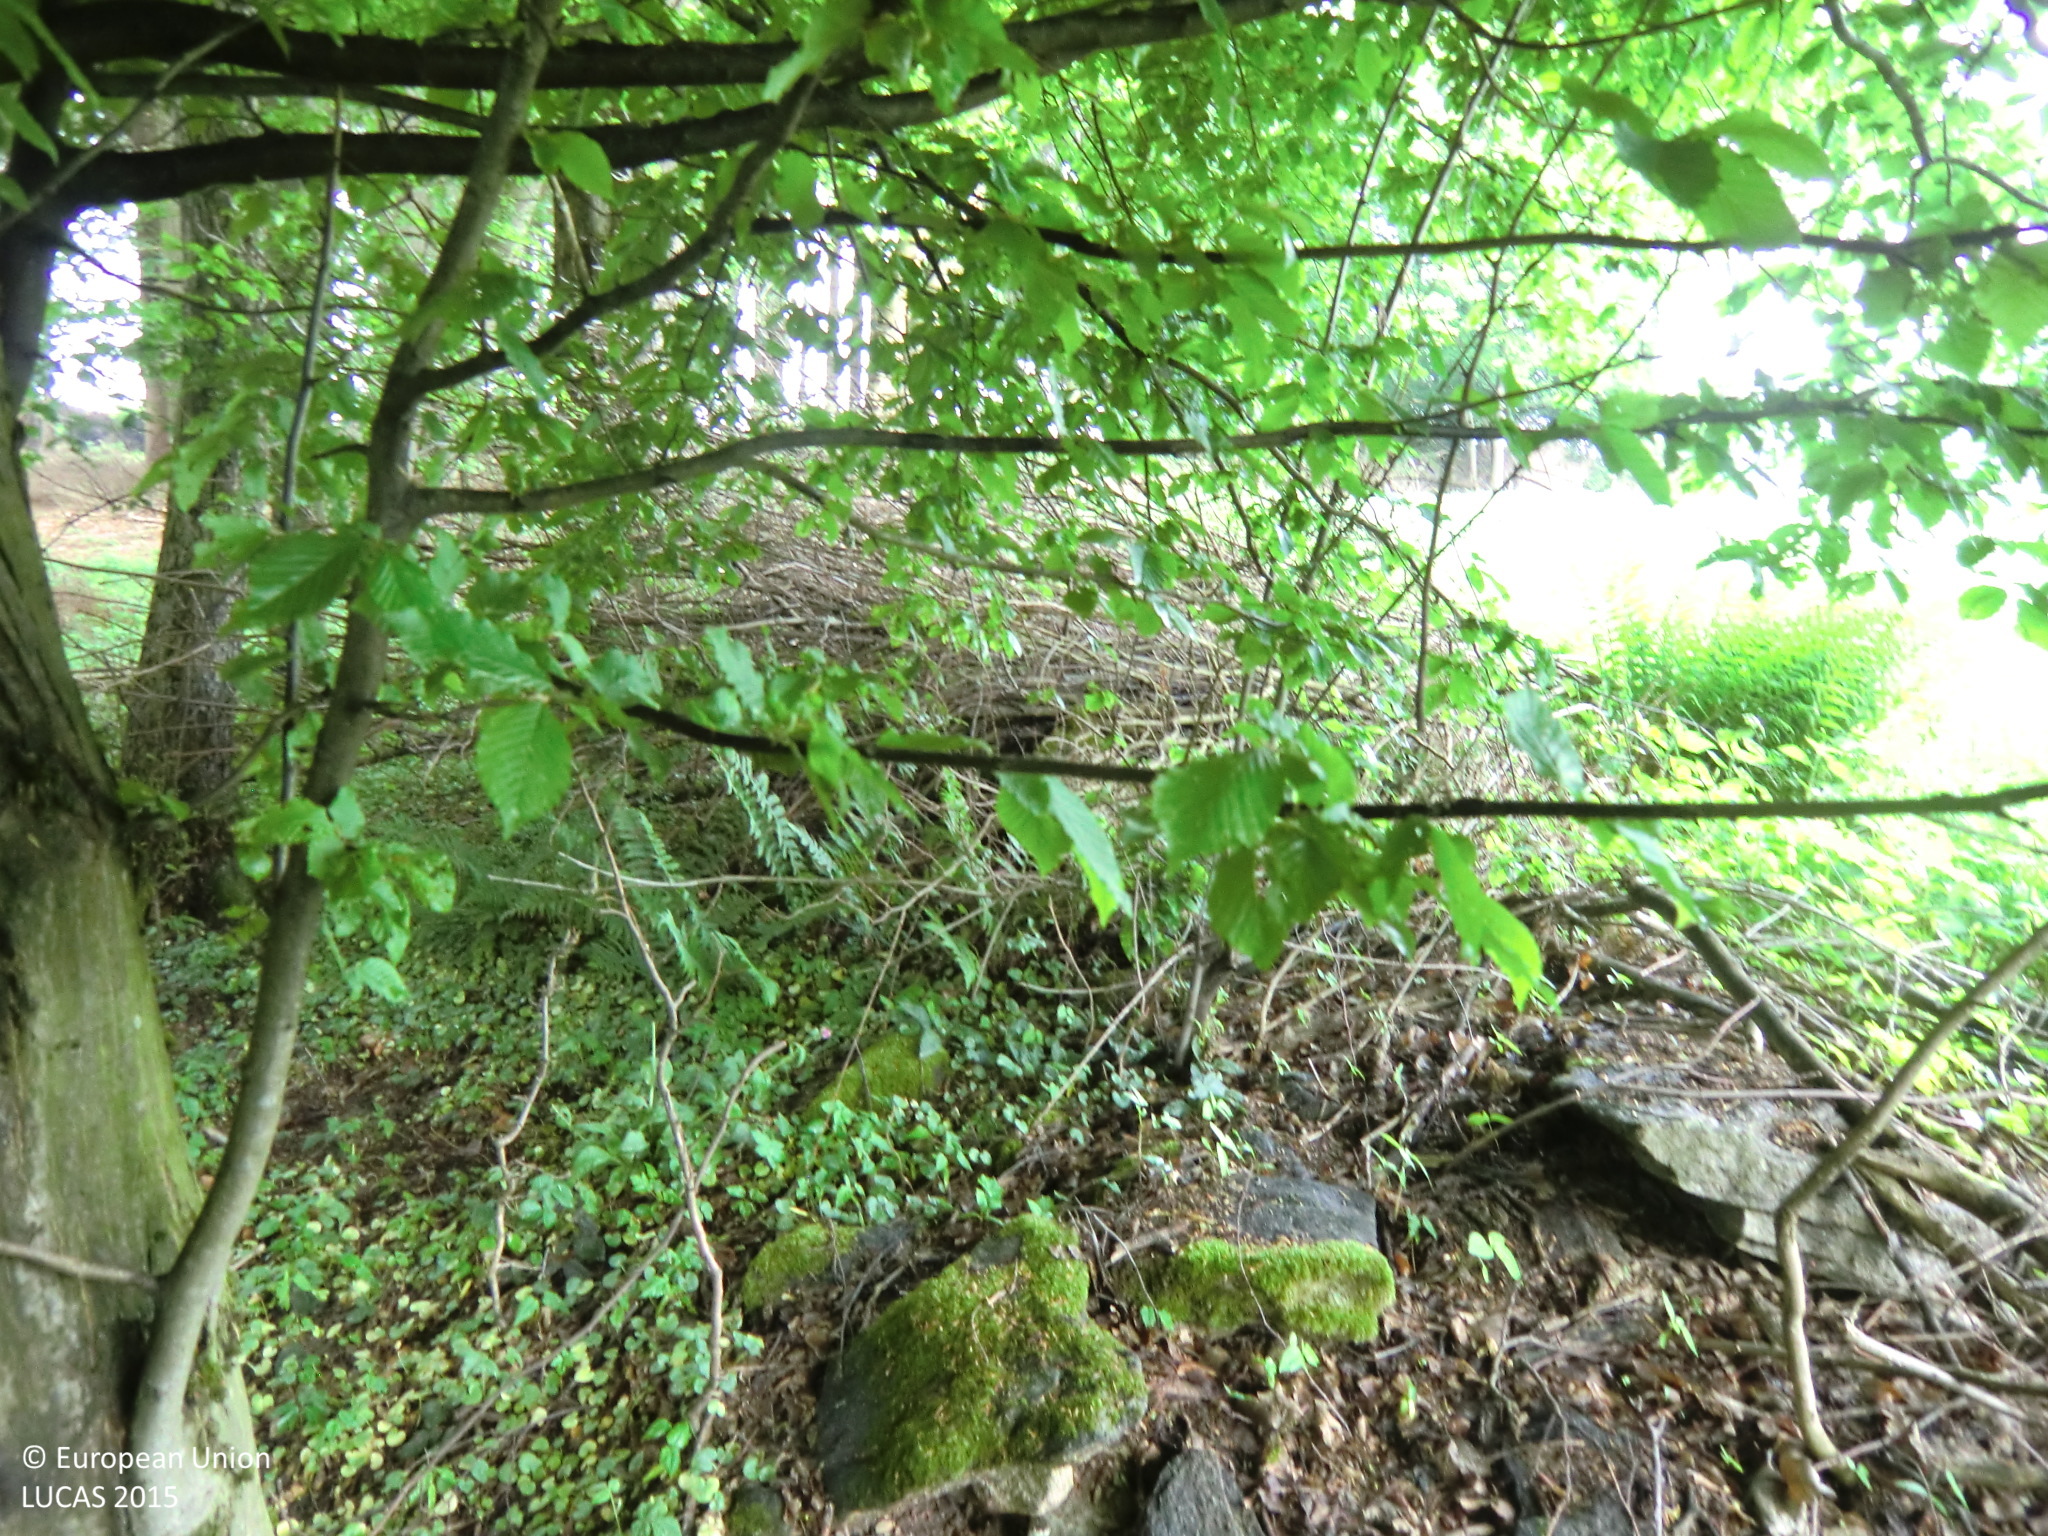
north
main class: Woodland
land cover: Broadleaved woodland
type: hemiboreal forest and nemoral coniferous forest and mixed broadleaved-coniferous forest
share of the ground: > 75 %
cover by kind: broadleaved forest trees 75 %, herbaceous plants 20 %, unconsolidated bare surface 5 %
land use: Forestry
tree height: > 5 m
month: May
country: AT
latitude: 48.3557
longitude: 14.3053
